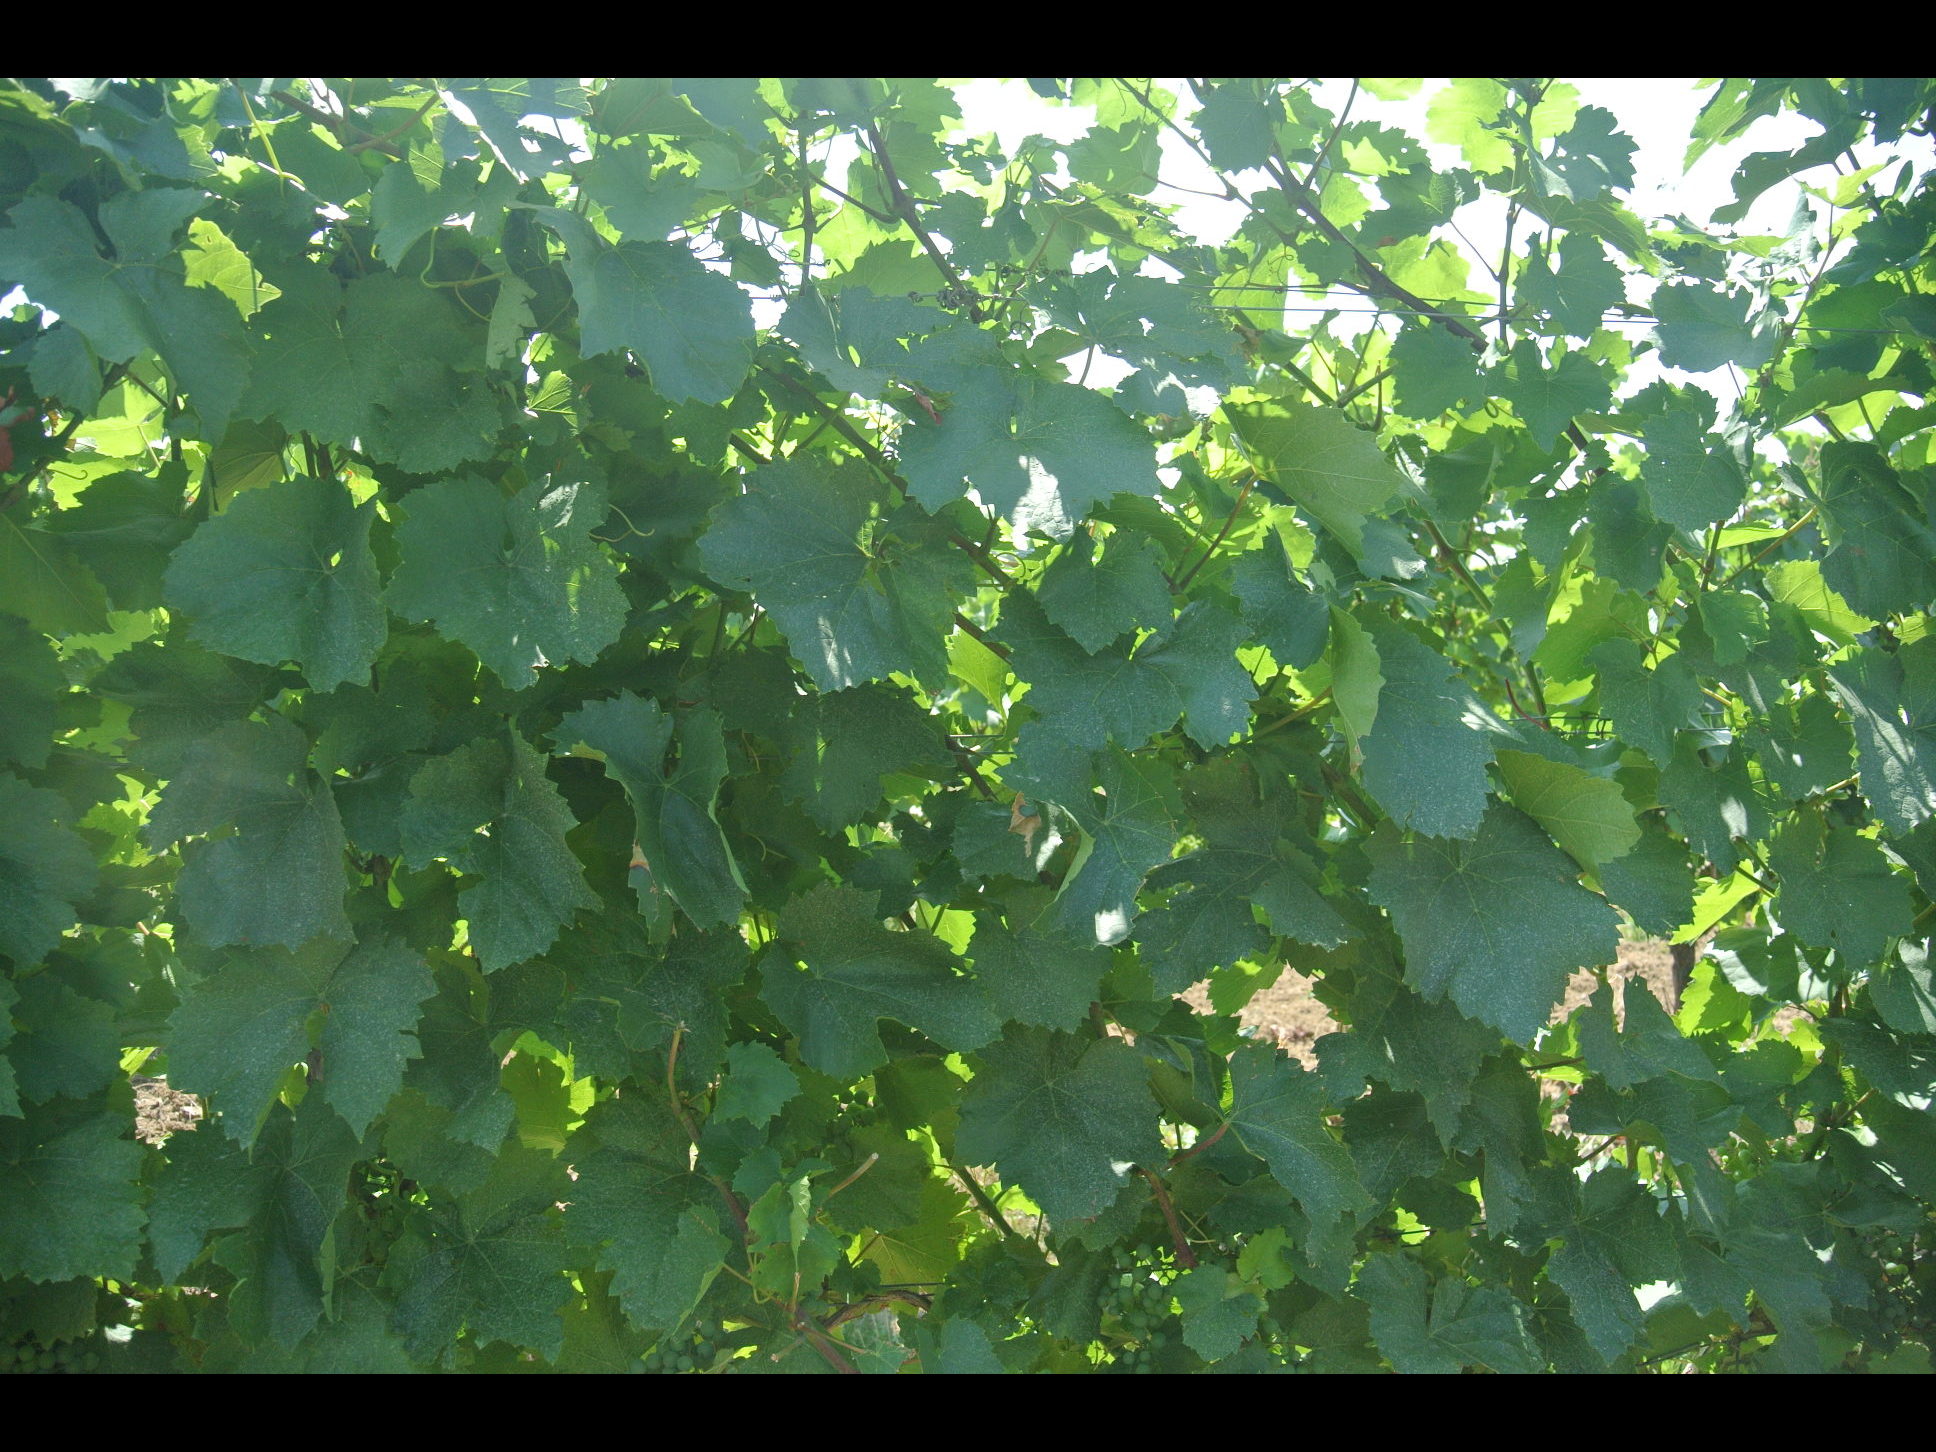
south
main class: Cropland
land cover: Vineyards
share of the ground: 25 - 50 %
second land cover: Other bare soil
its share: > 75 %
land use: Agriculture (excluding fallow land and kitchen gardens)
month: July
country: AT
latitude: 47.5768
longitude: 16.5584
